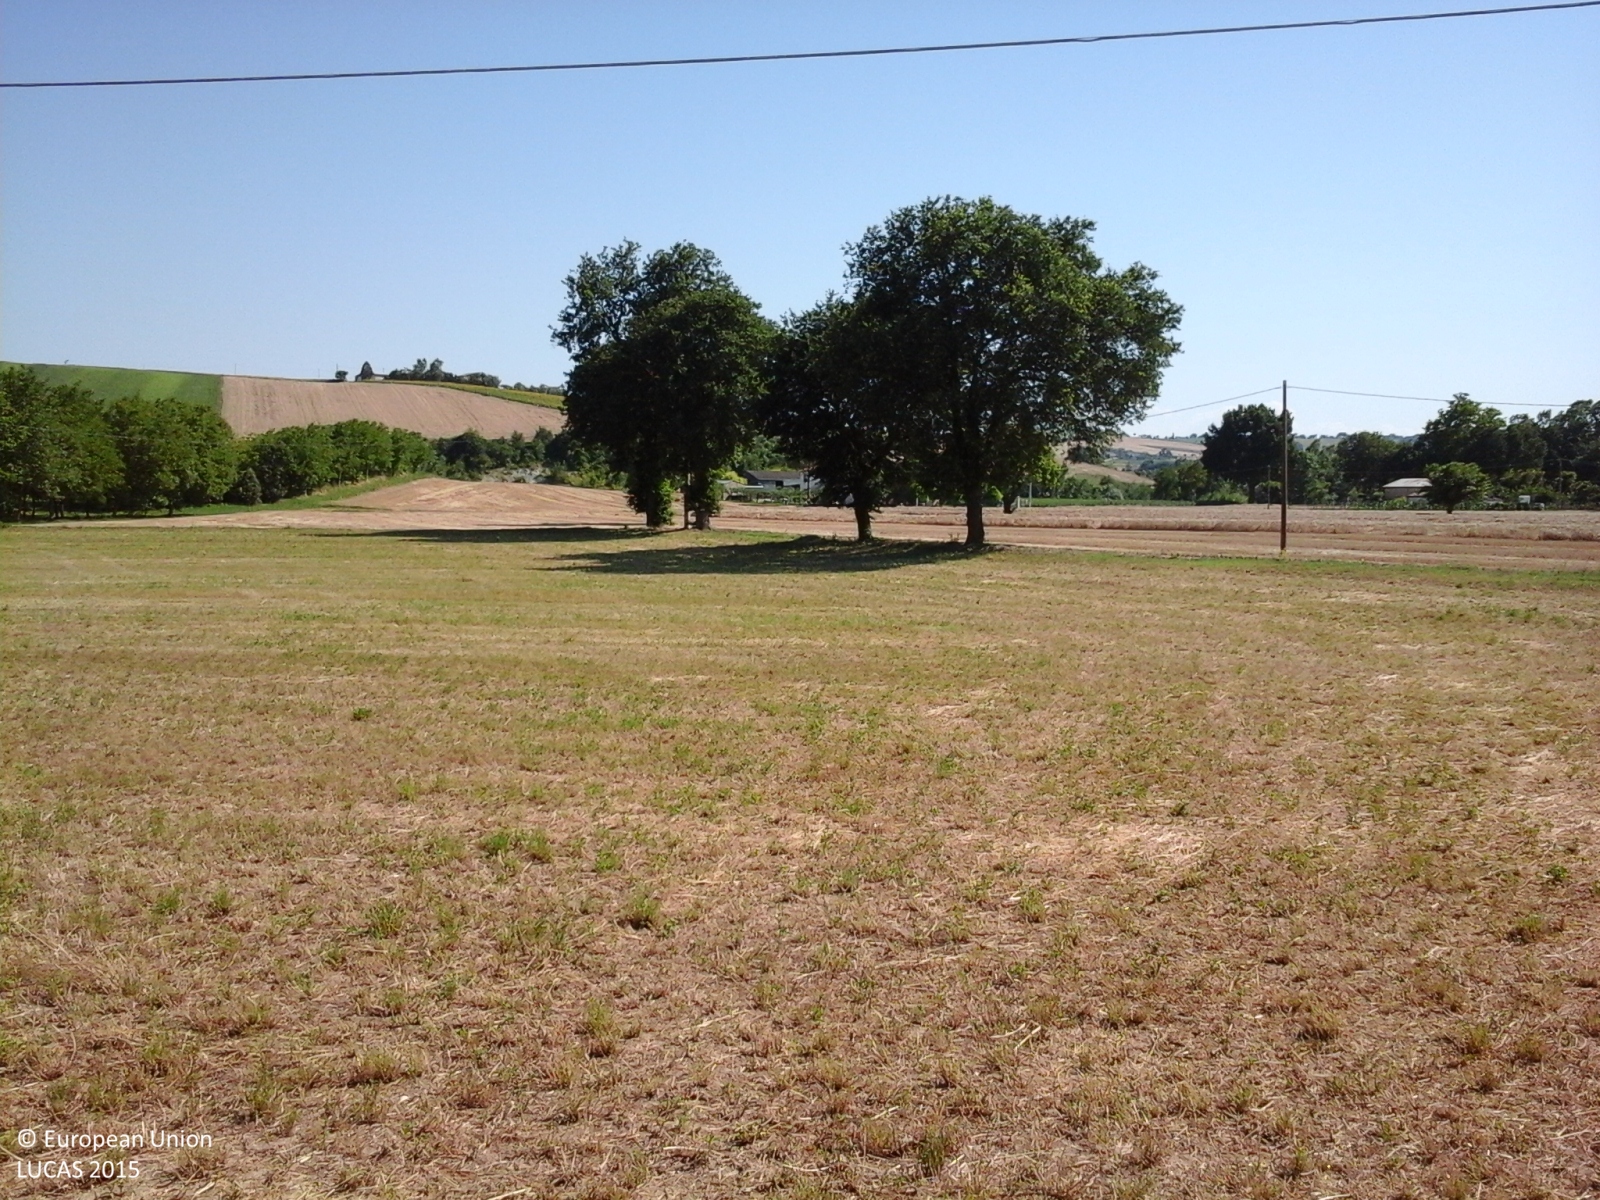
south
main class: Cropland
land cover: Lucerne
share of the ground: > 75 %
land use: Agriculture (excluding fallow land and kitchen gardens)
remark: Harvested field
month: July
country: IT
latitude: 43.3949
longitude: 13.3127
